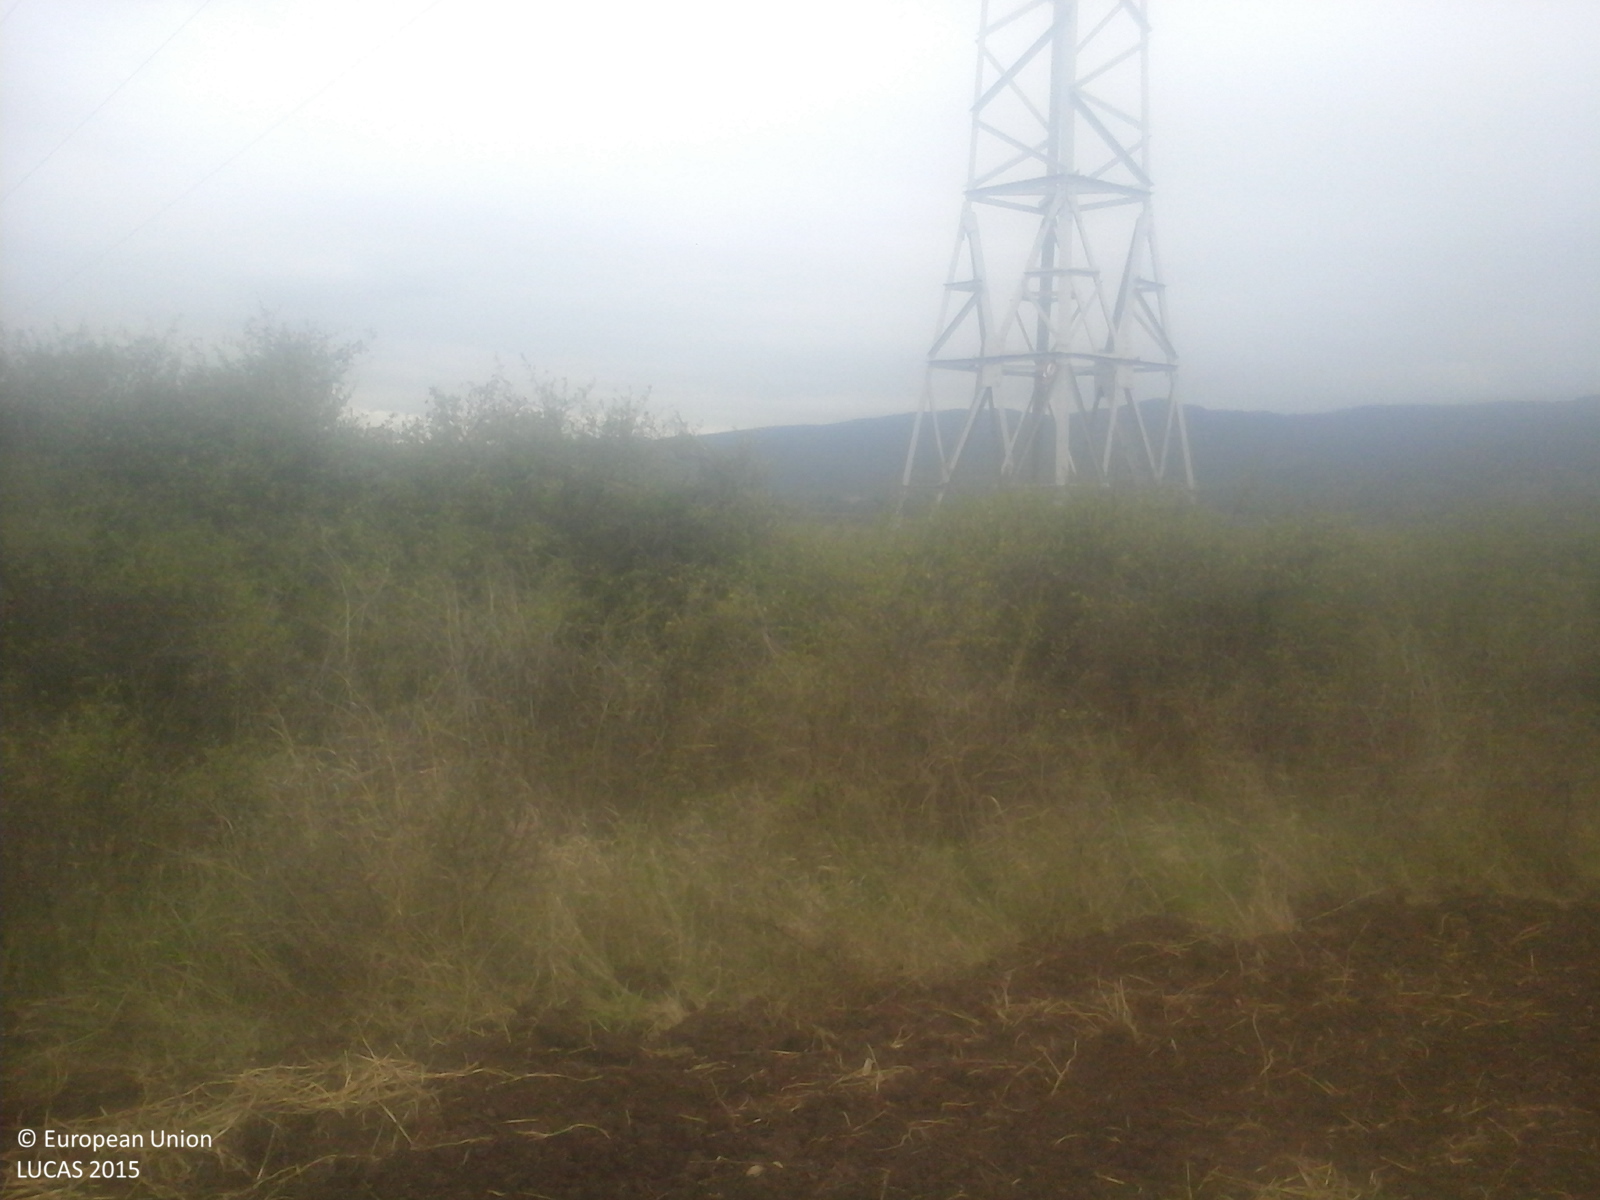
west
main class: Cropland
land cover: Common wheat
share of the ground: < 10 %
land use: Agriculture (excluding fallow land and kitchen gardens)
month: September
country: RO
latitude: 45.9399
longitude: 23.4125
